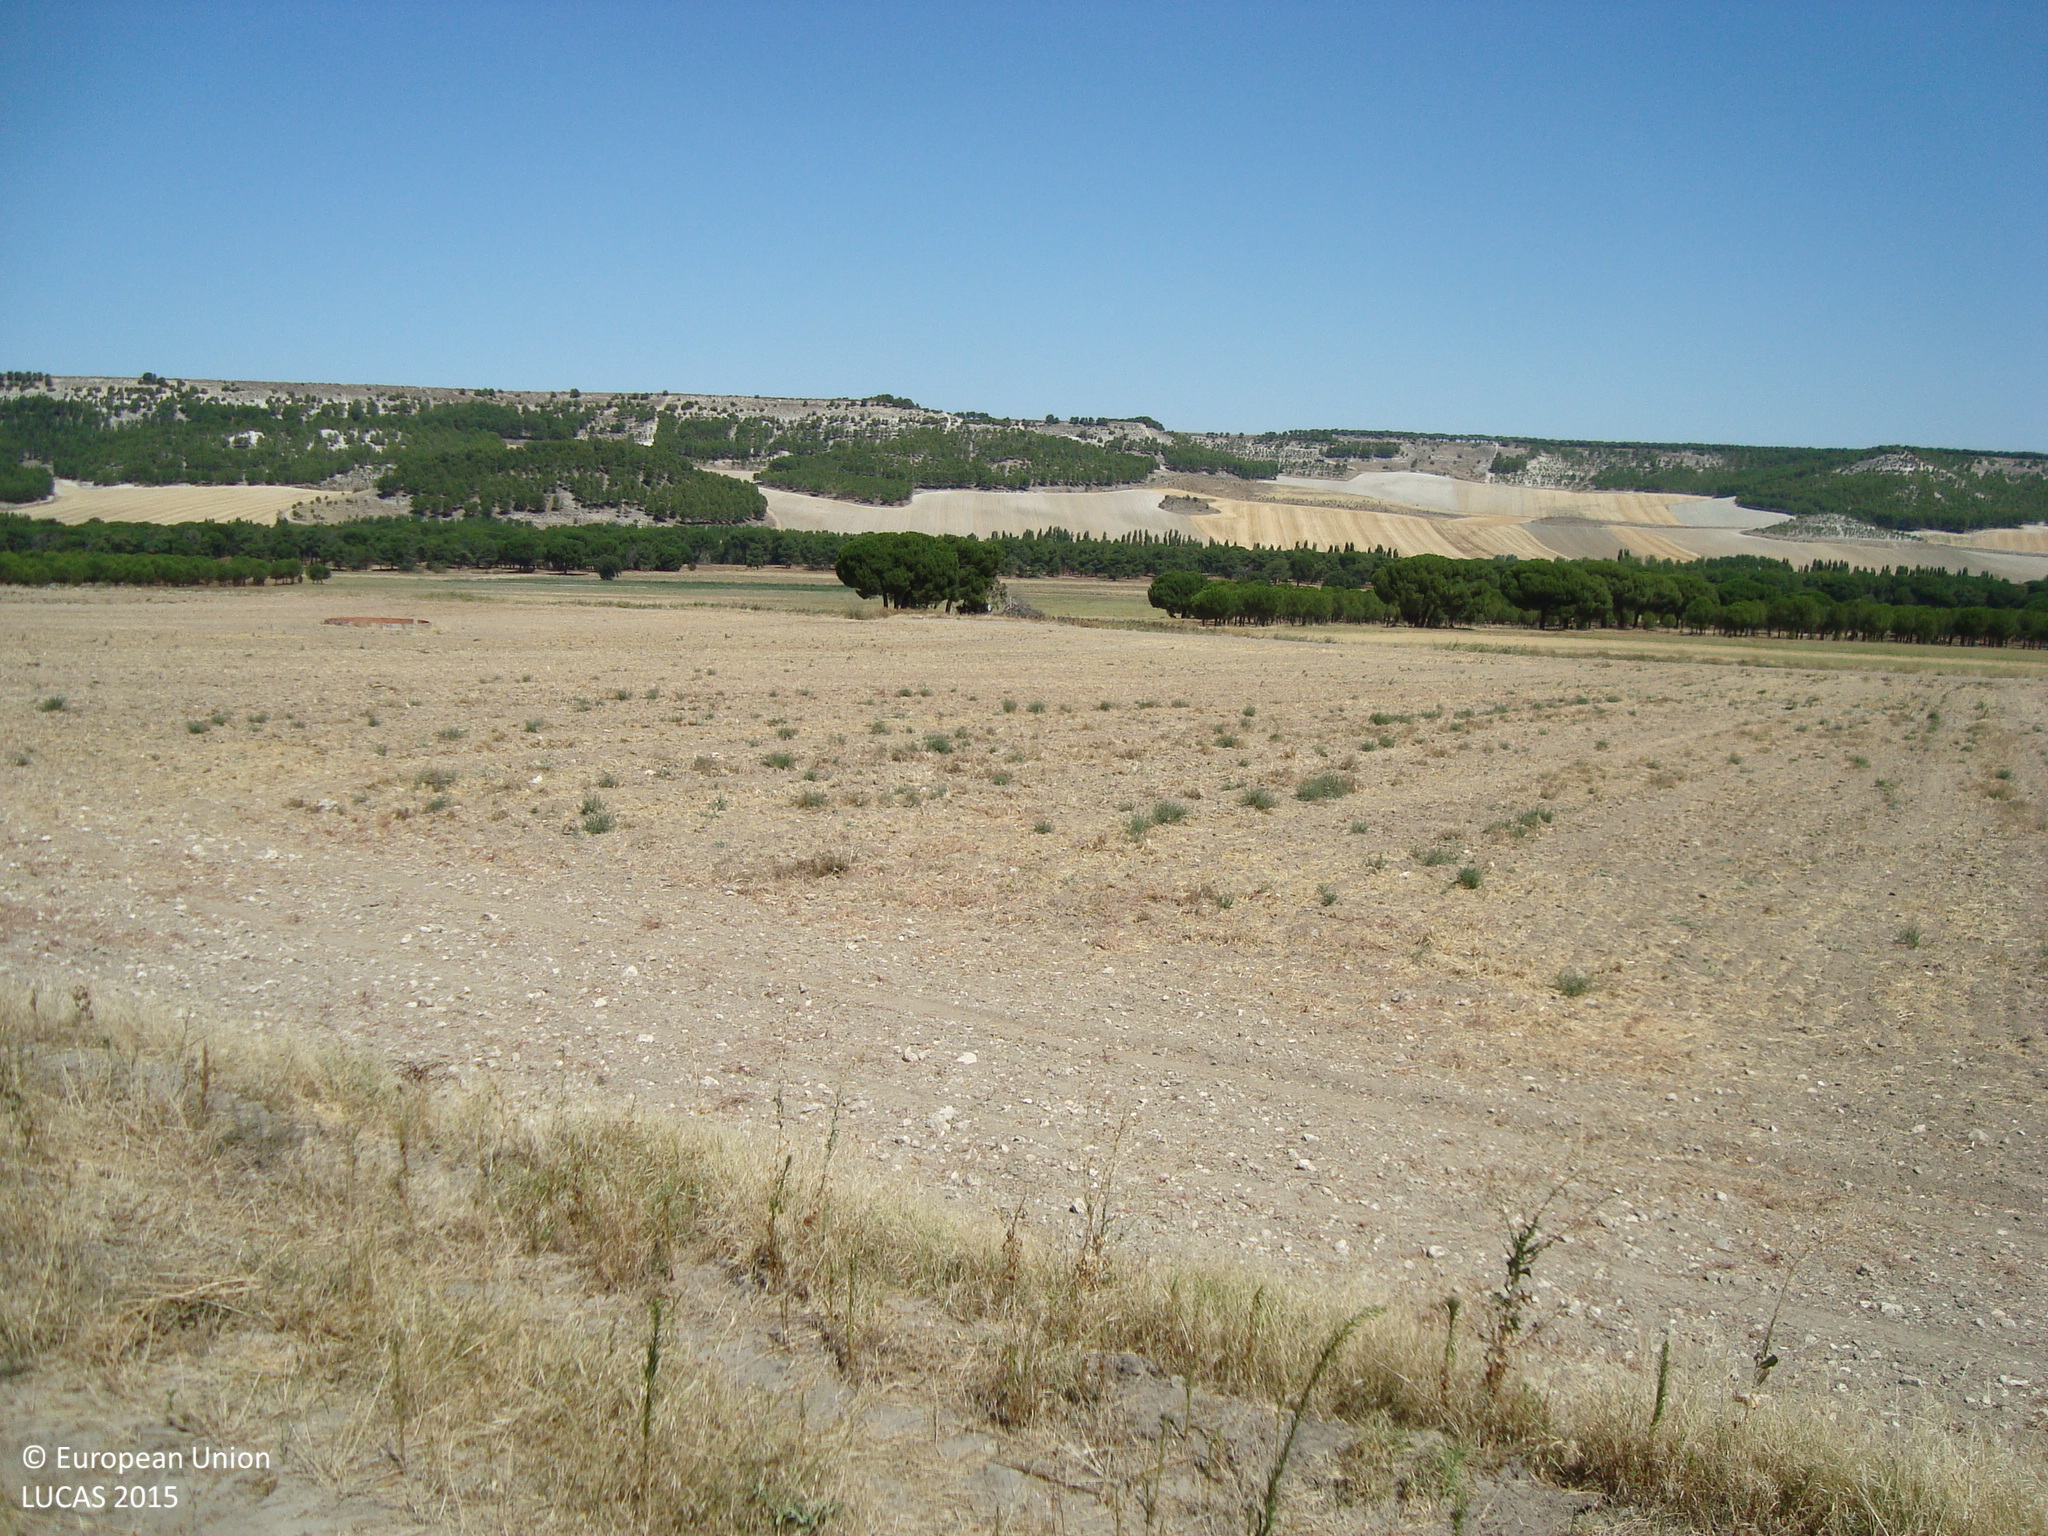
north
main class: Woodland
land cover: Pine dominated coniferous woodland
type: coniferous forest of the mediterranean region
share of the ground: 25 - 50 %
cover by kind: herbaceous plants 60 %, coniferous forest trees 40 %
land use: Forestry
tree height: < 5 m
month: August
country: ES
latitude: 41.4066
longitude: -4.5980
